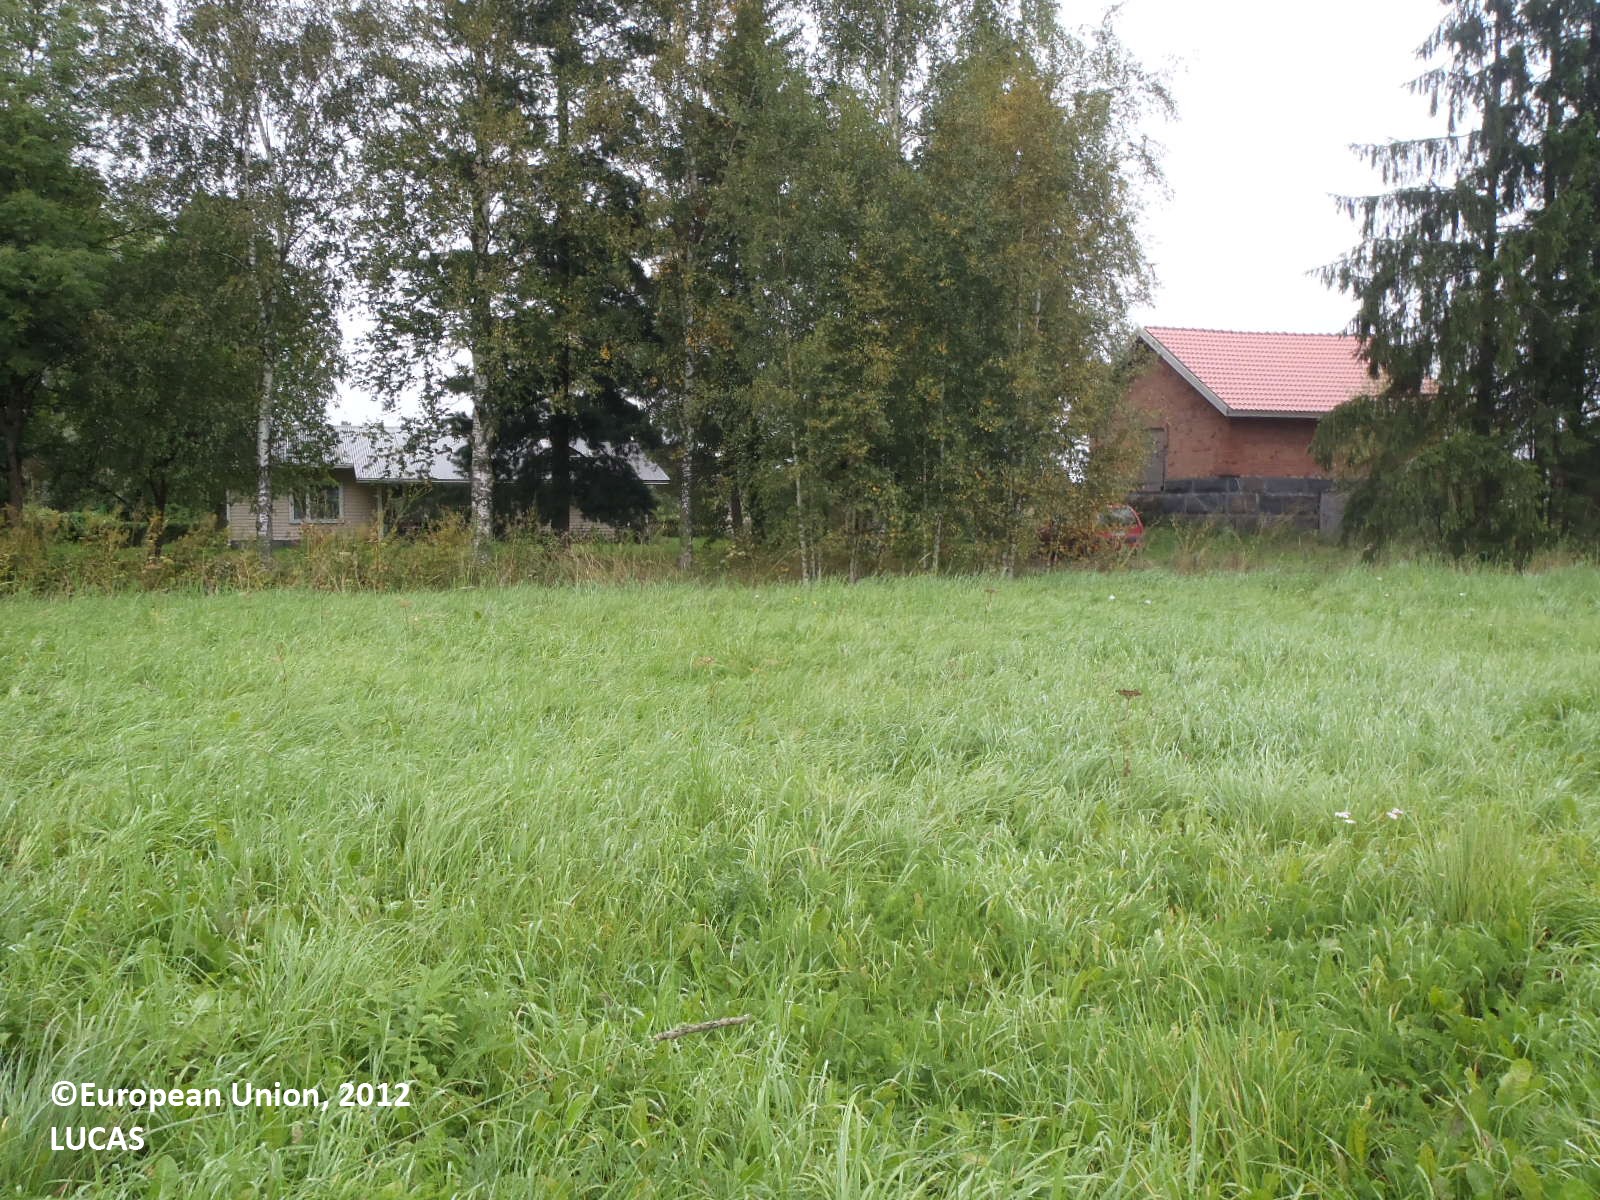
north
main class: Grassland
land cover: Grassland without tree/shrub cover
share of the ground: > 75 %
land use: Agriculture (excluding fallow land and kitchen gardens)
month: September
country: FI
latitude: 61.0315
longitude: 22.6741
